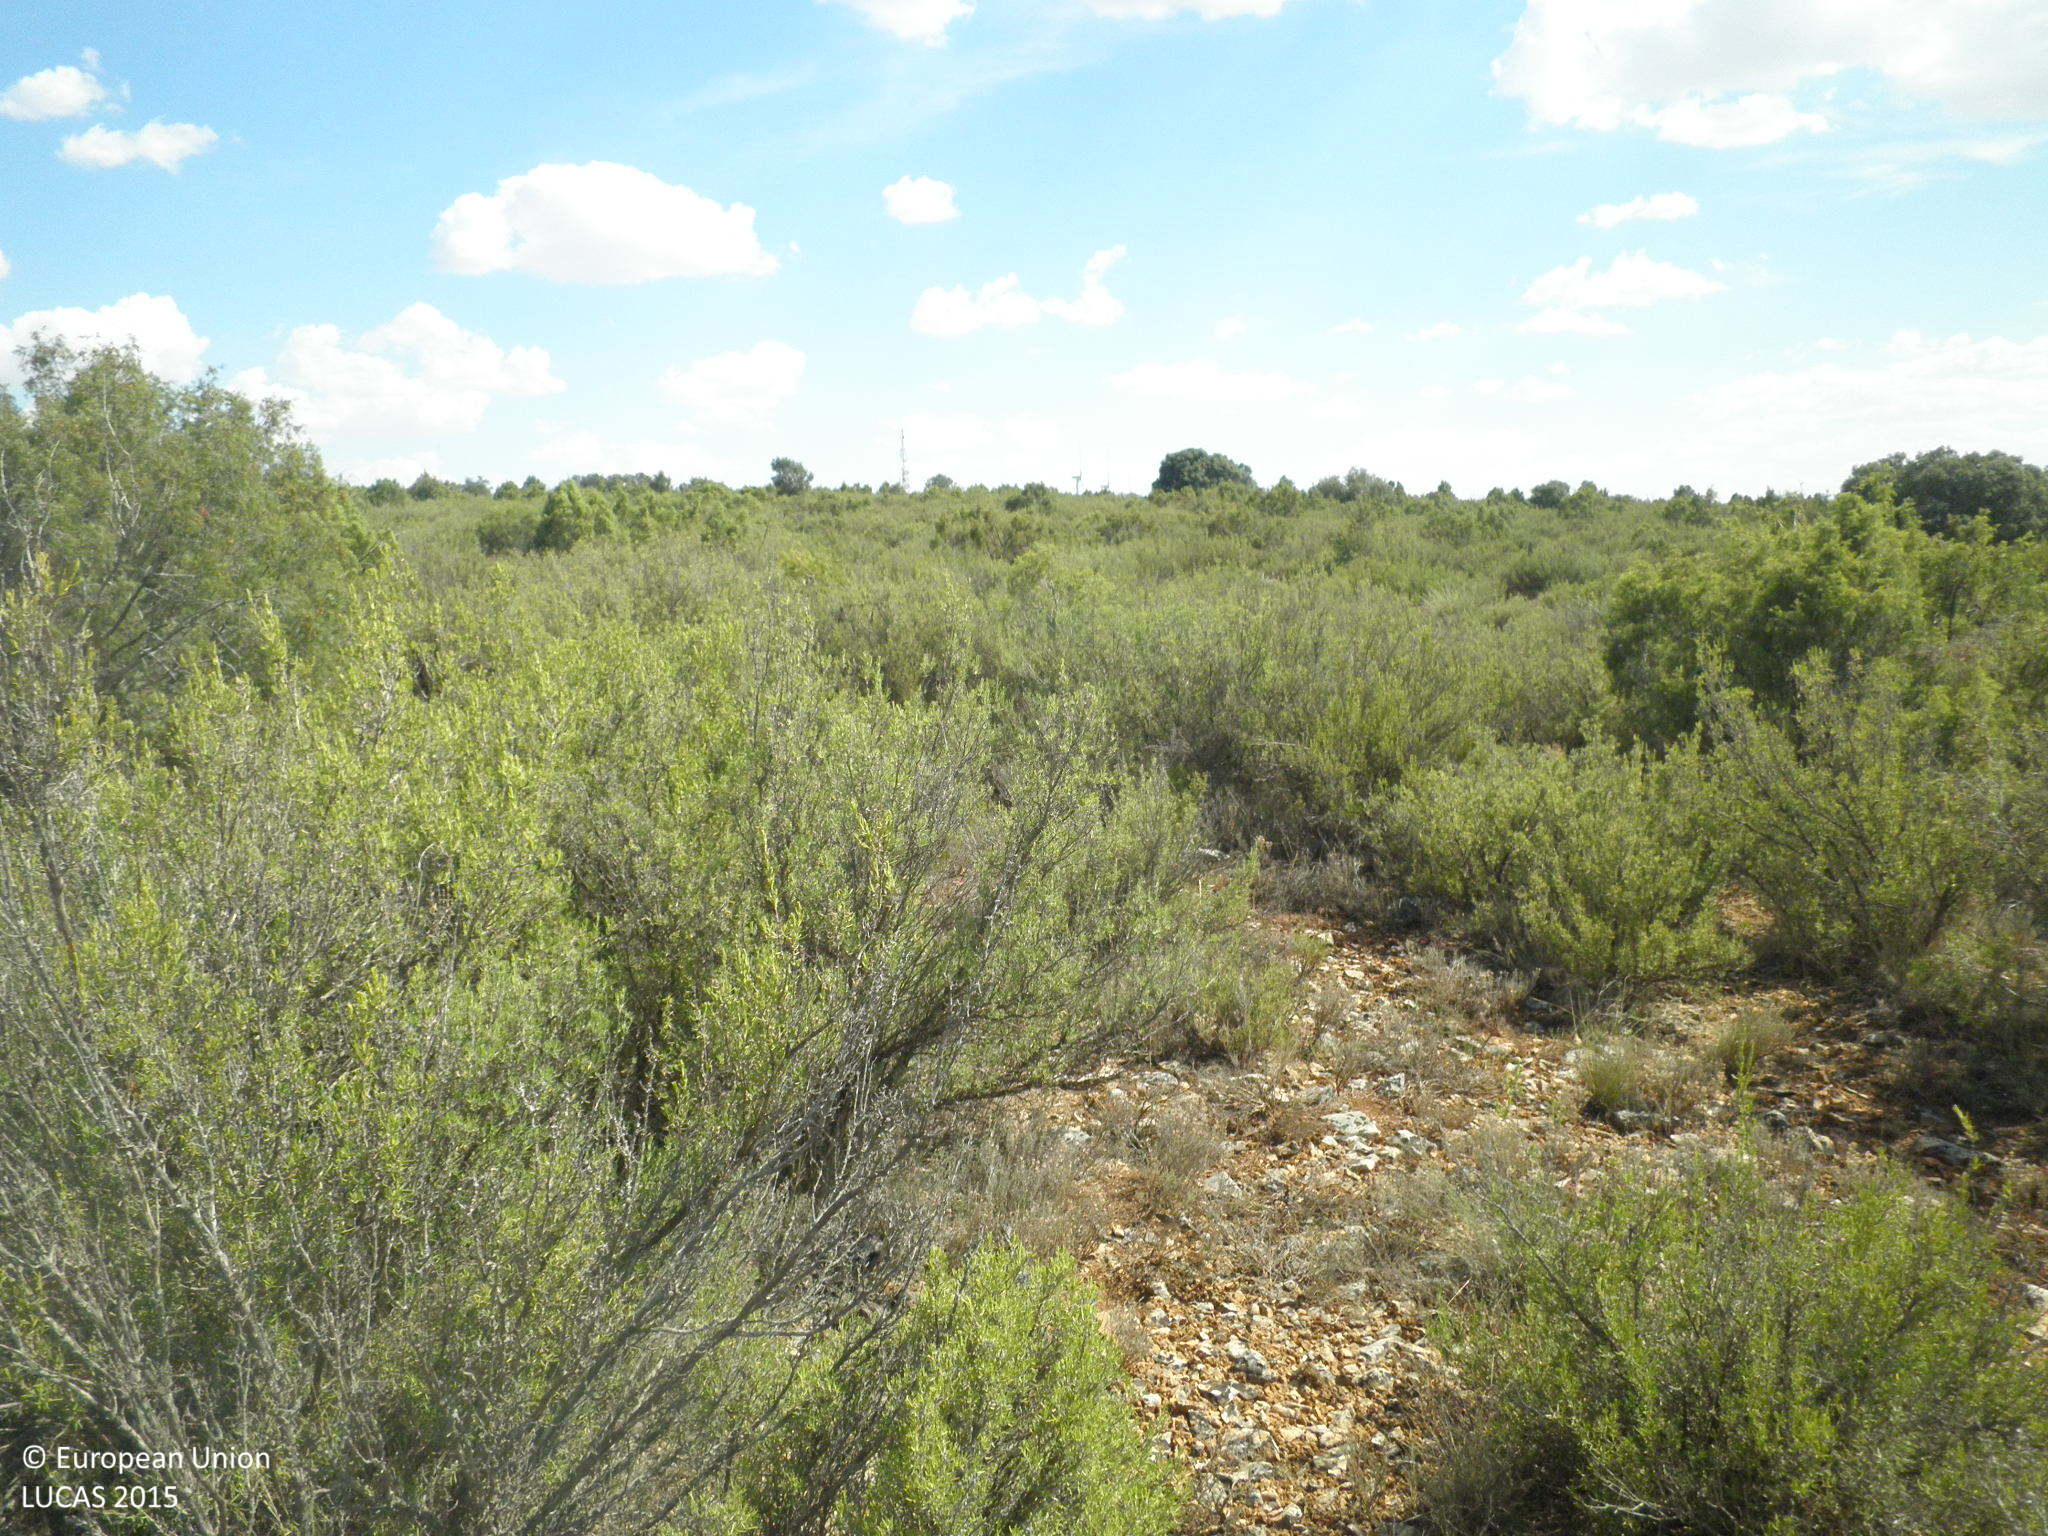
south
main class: Shrubland
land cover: Shrubland with sparse tree cover
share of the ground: 25 - 50 %
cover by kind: shrubs 40 %, unconsolidated bare surface 40 %, consolidated bare surface 10 %, broadleaved forest trees 5 %, herbaceous plants 5 %
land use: Semi-natural and natural areas not in use
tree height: < 5 m
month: July
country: ES
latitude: 39.6424
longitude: -1.8122
